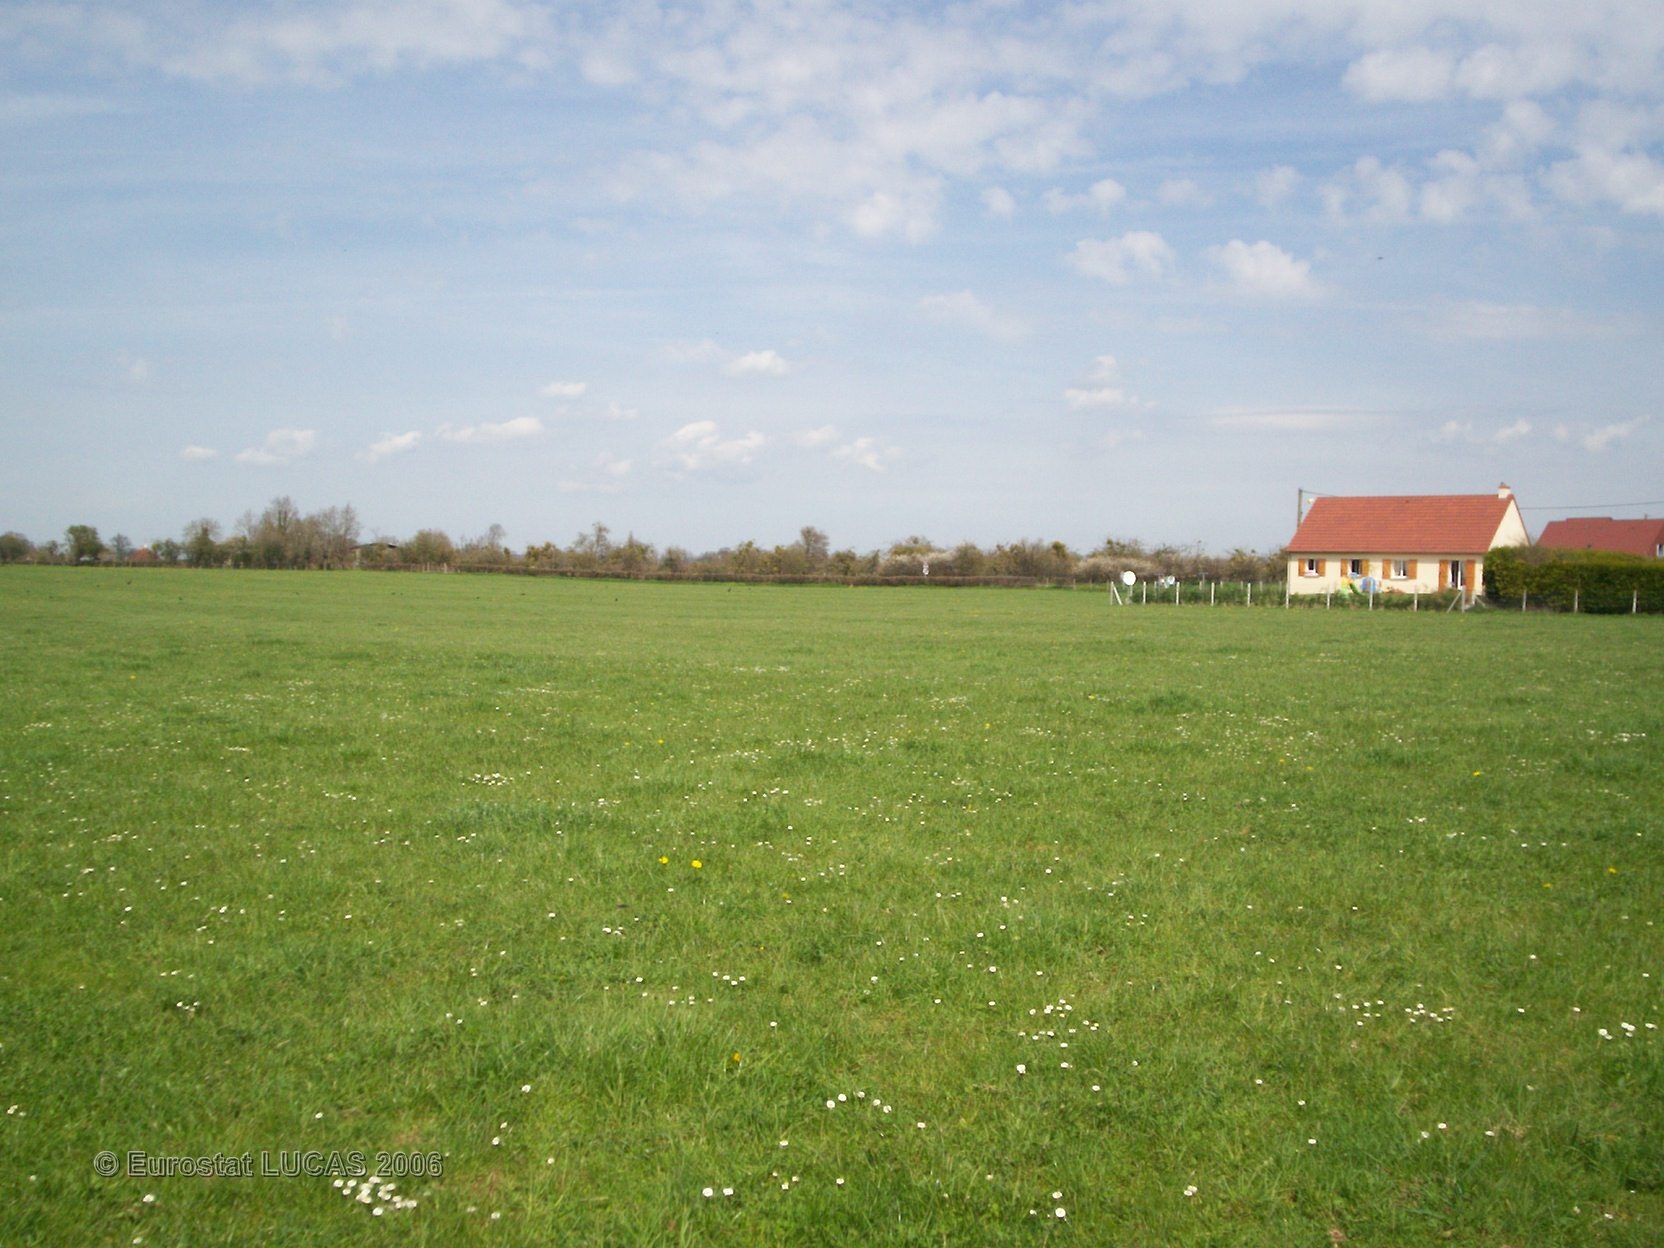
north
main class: Grassland
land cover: Grassland without tree/shrub cover
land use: Agriculture (excluding fallow land and kitchen gardens)
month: April
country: FR
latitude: 48.8099
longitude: 0.0983
